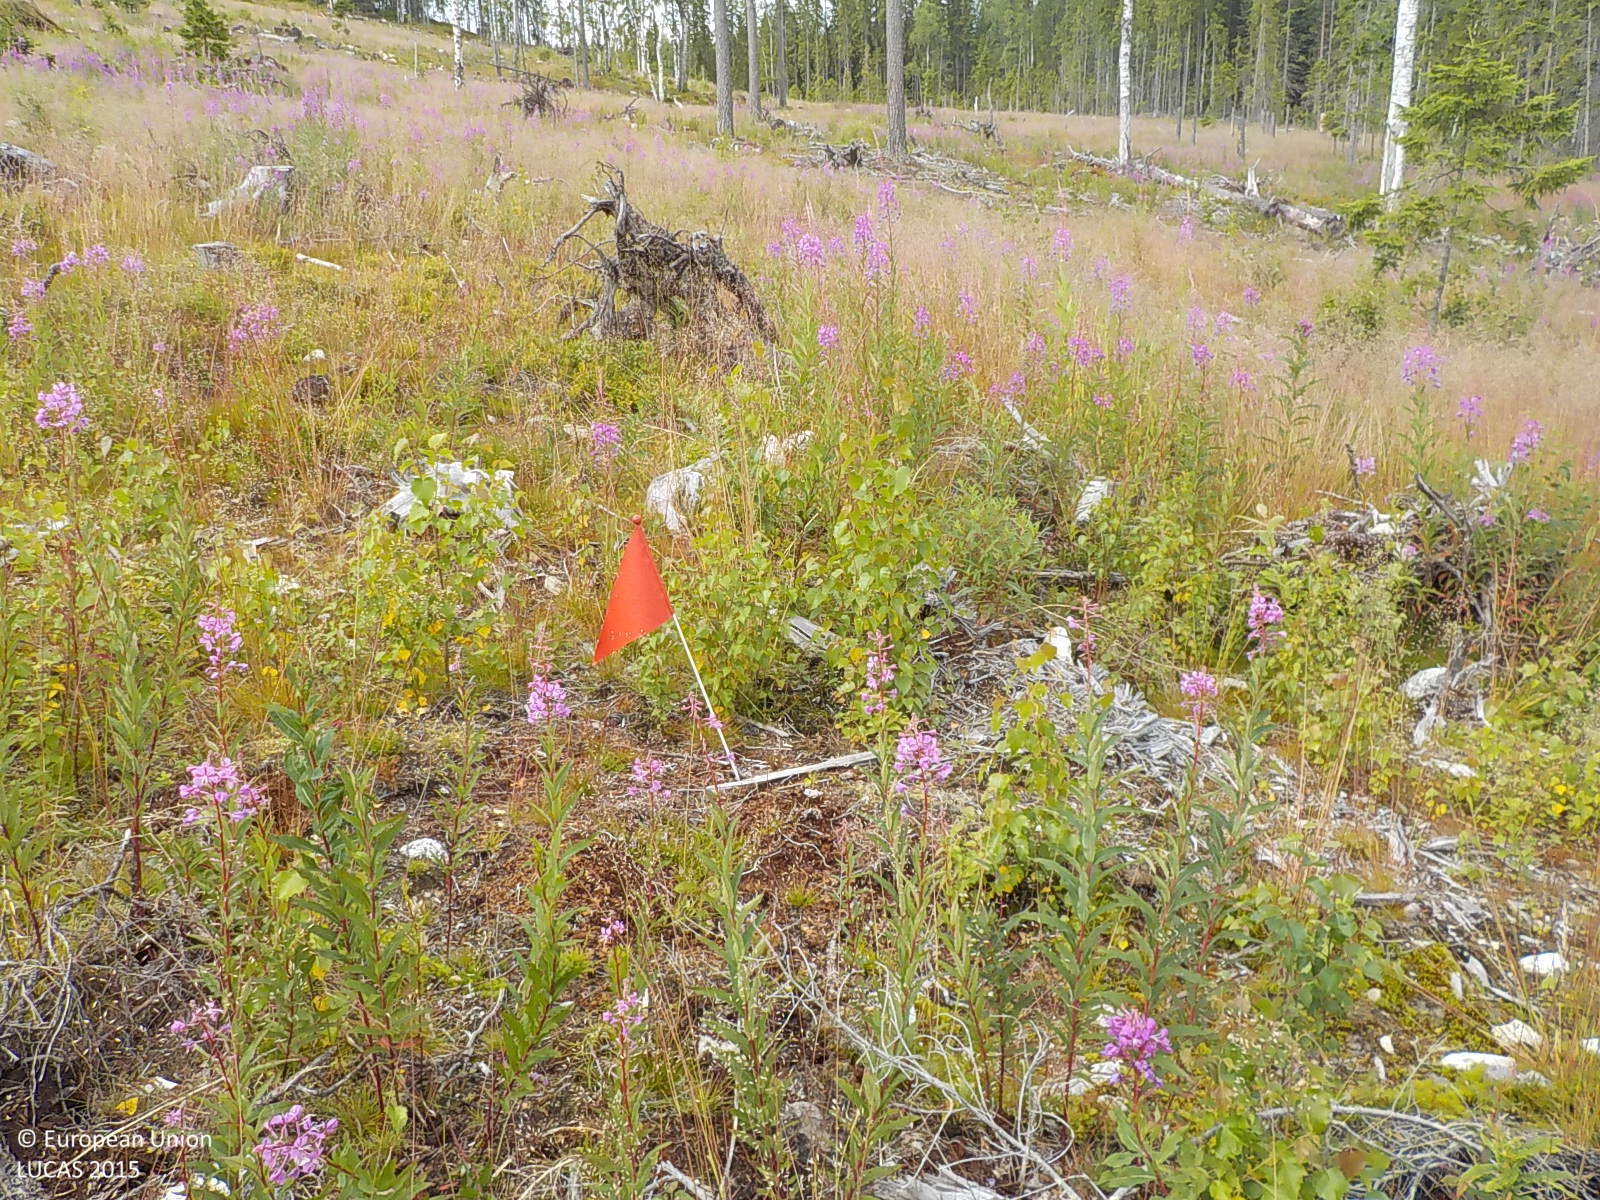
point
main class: Woodland
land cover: Broadleaved woodland
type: boreal forest
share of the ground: 50 - 75 %
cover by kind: broadleaved forest trees 50 %, herbaceous plants 45 %, shrubs 5 %
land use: Forestry
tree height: < 5 m
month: July
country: SE
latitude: 63.2657
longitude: 17.3675
